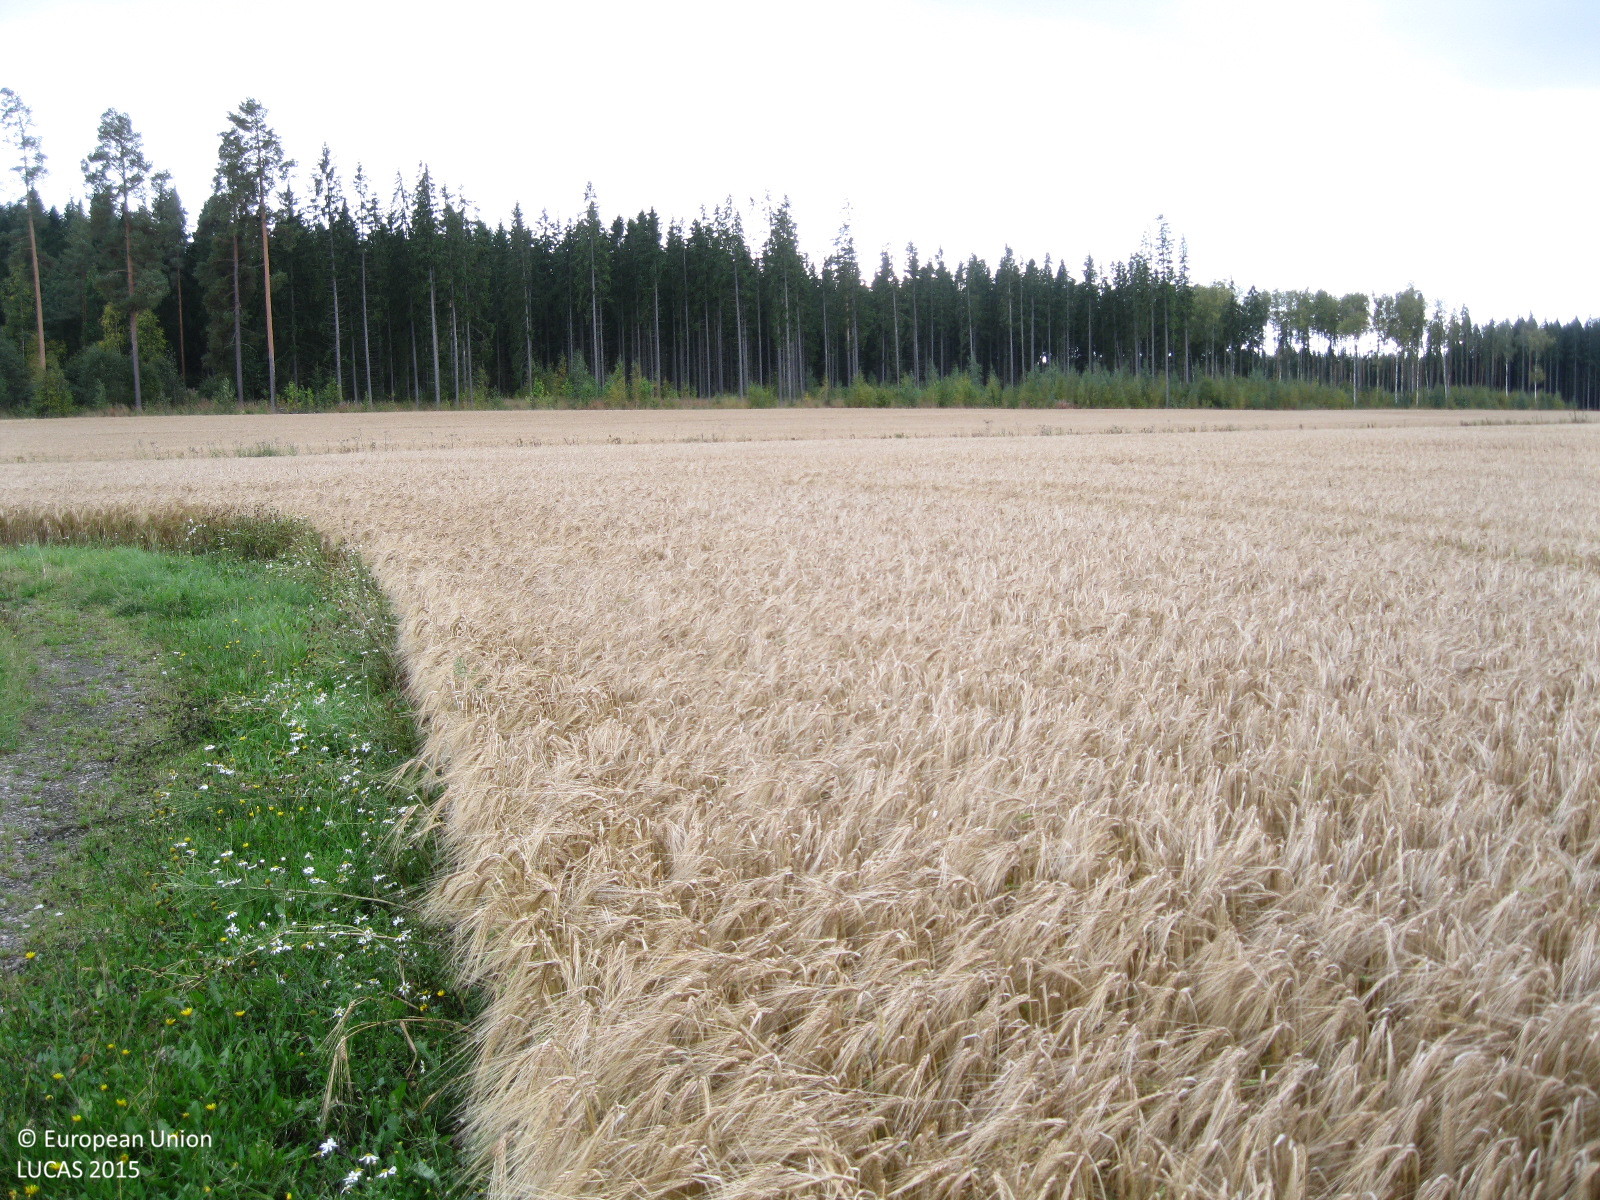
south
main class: Cropland
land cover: Barley
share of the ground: > 75 %
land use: Agriculture (excluding fallow land and kitchen gardens)
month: September
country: FI
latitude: 60.8224
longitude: 24.8404
